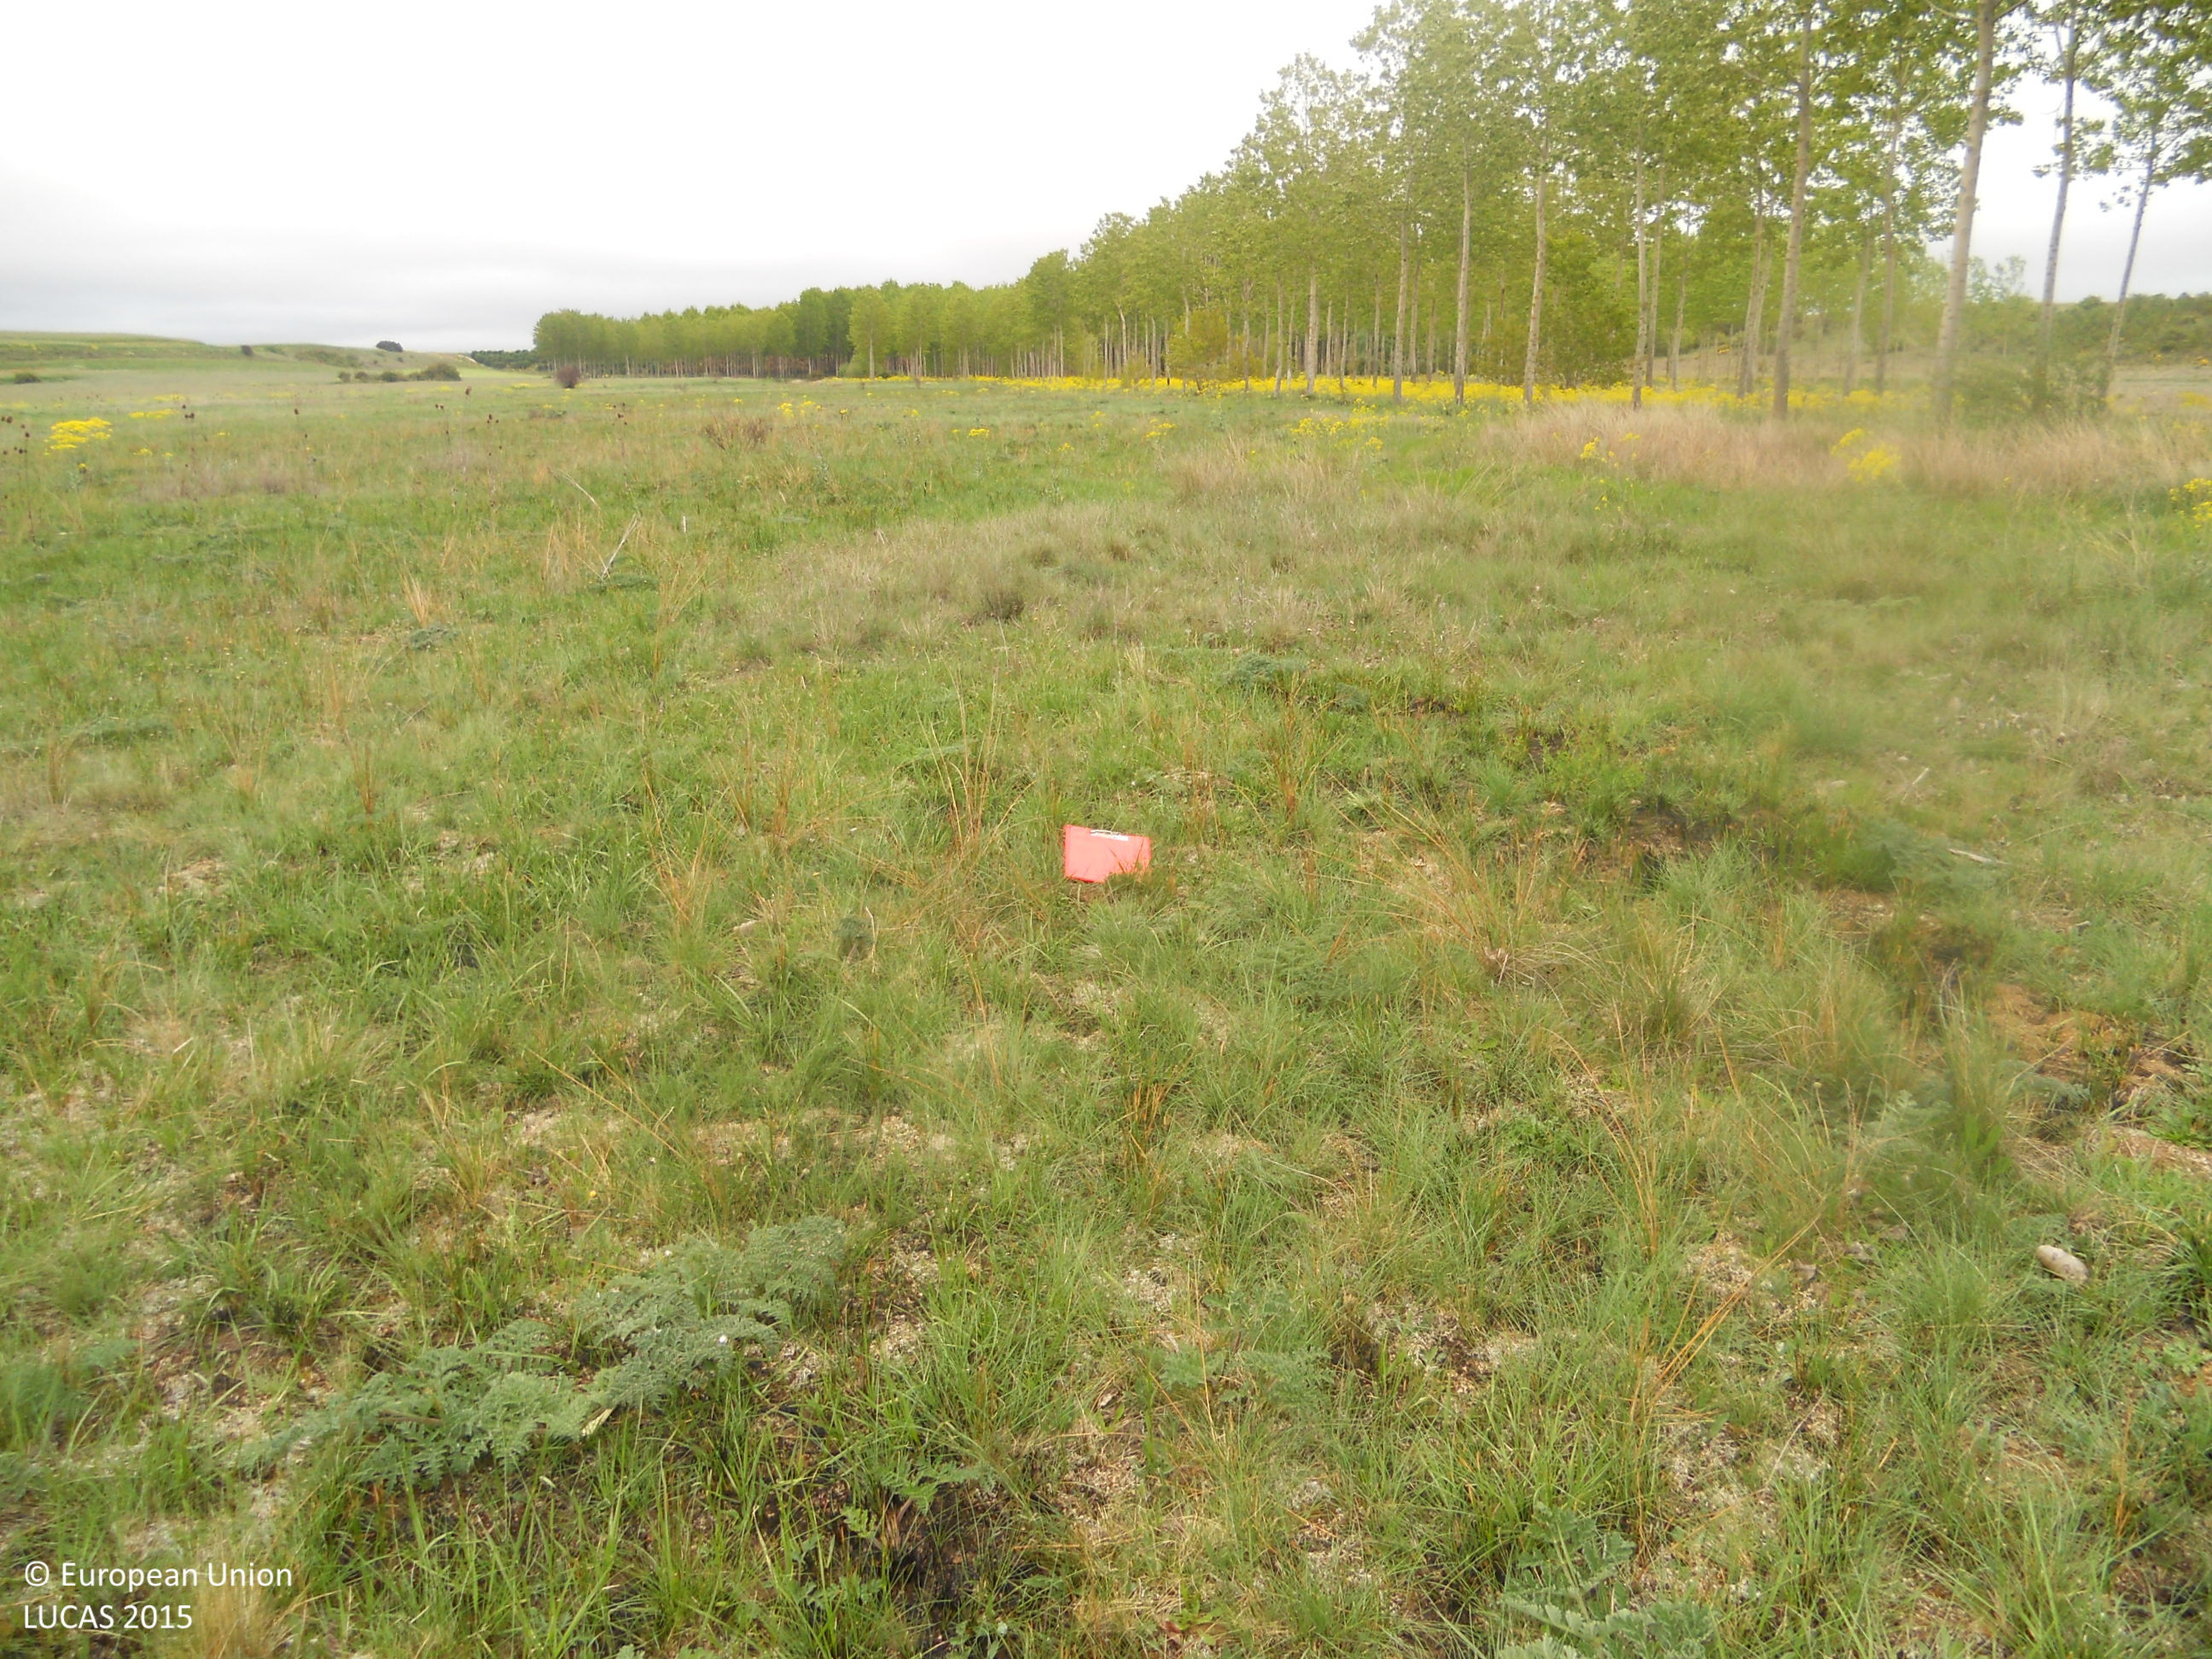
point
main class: Grassland
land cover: Grassland without tree/shrub cover
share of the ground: > 75 %
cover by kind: herbaceous plants 95 %, shrubs 5 %
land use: Agriculture (excluding fallow land and kitchen gardens)
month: May
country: ES
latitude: 42.4697
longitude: -5.3305
